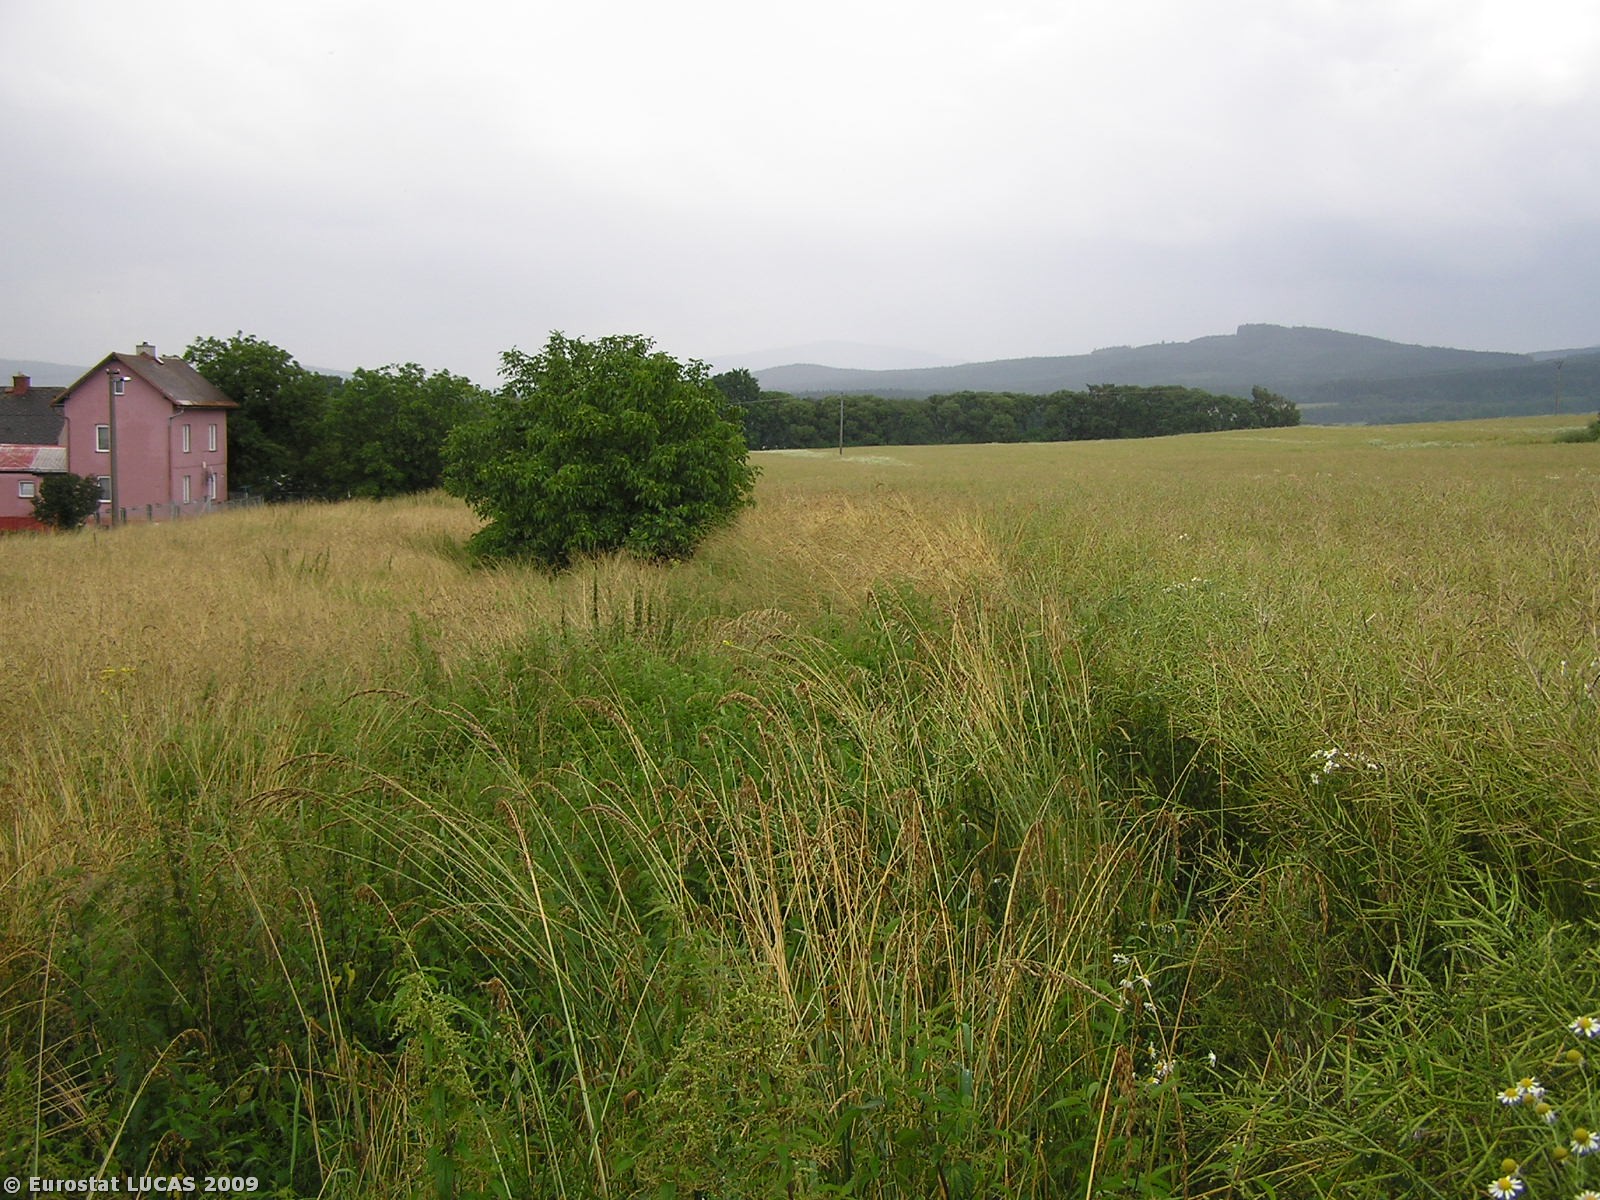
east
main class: Cropland
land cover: Rape and turnip rape
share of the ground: > 75 %
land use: Agriculture (excluding fallow land and kitchen gardens)
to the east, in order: Rape and turnip rape
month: July
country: CZ
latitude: 50.2773
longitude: 17.2659
